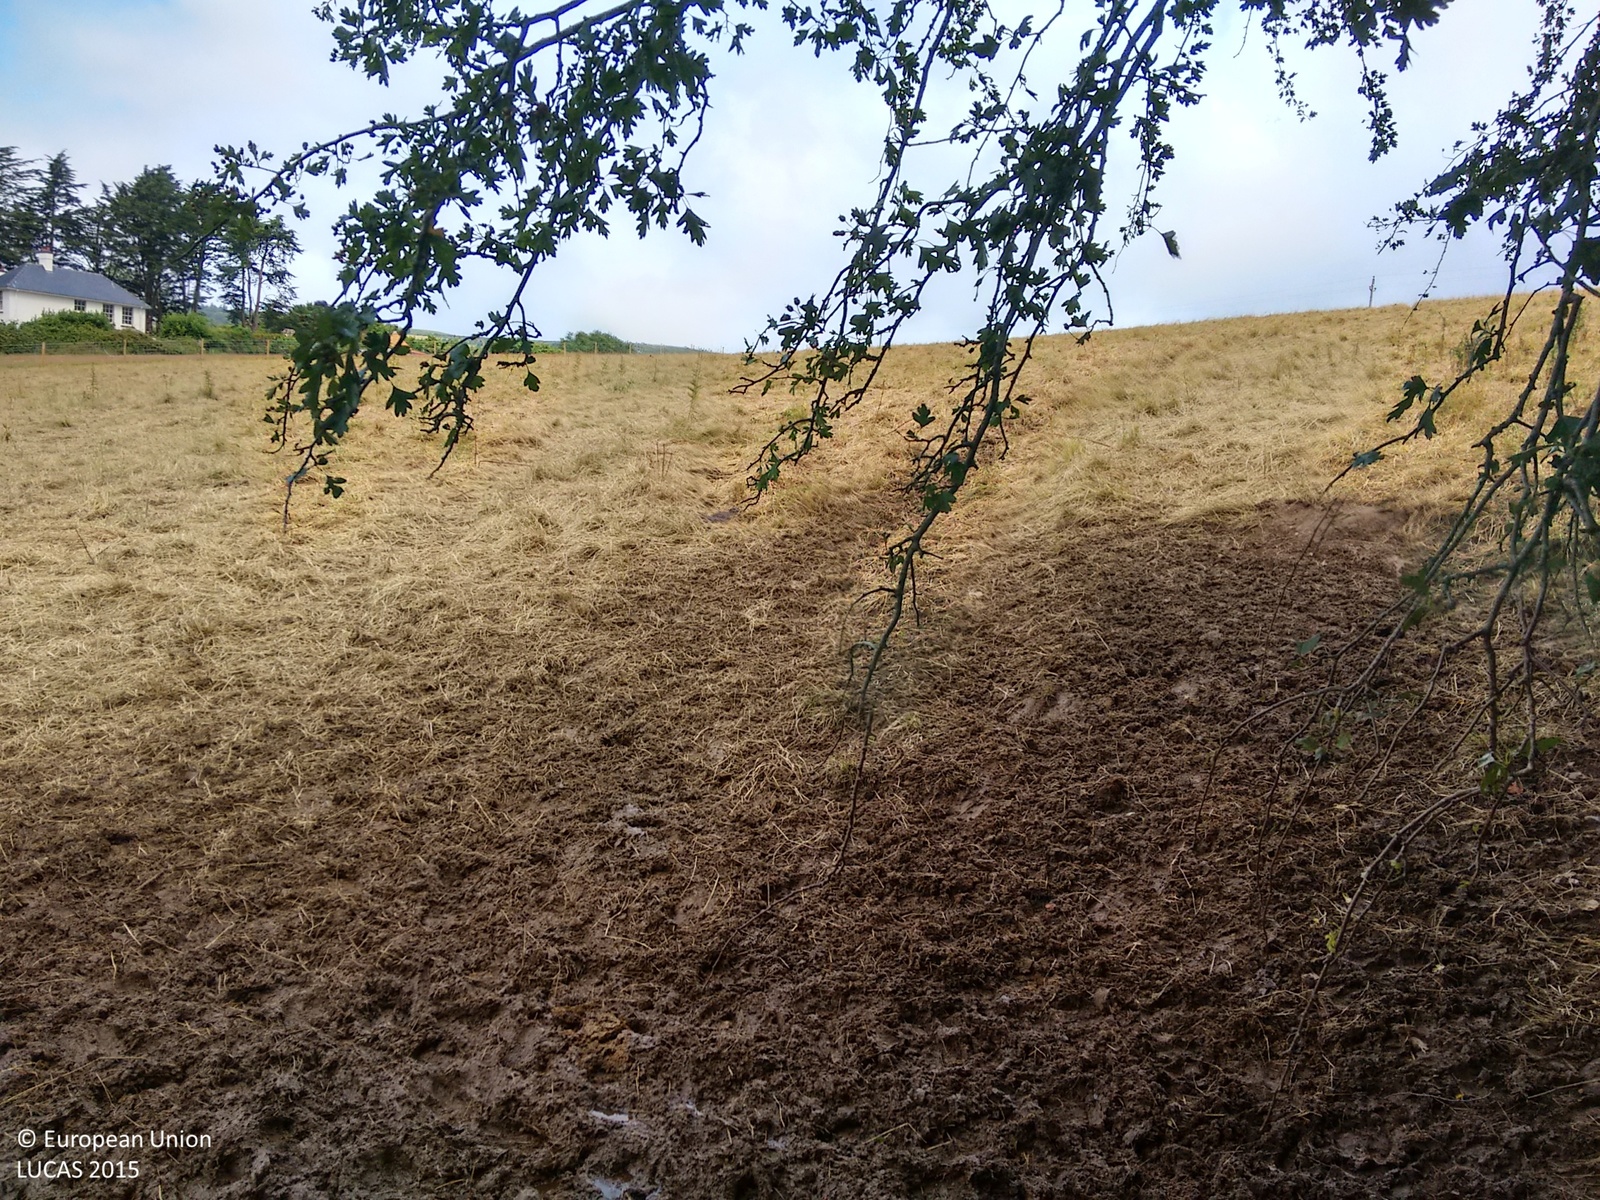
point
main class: Grassland
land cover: Grassland without tree/shrub cover
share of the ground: > 75 %
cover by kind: herbaceous plants 100 %
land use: Agriculture (excluding fallow land and kitchen gardens)
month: July
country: GB
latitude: 50.5729
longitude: -3.7139
